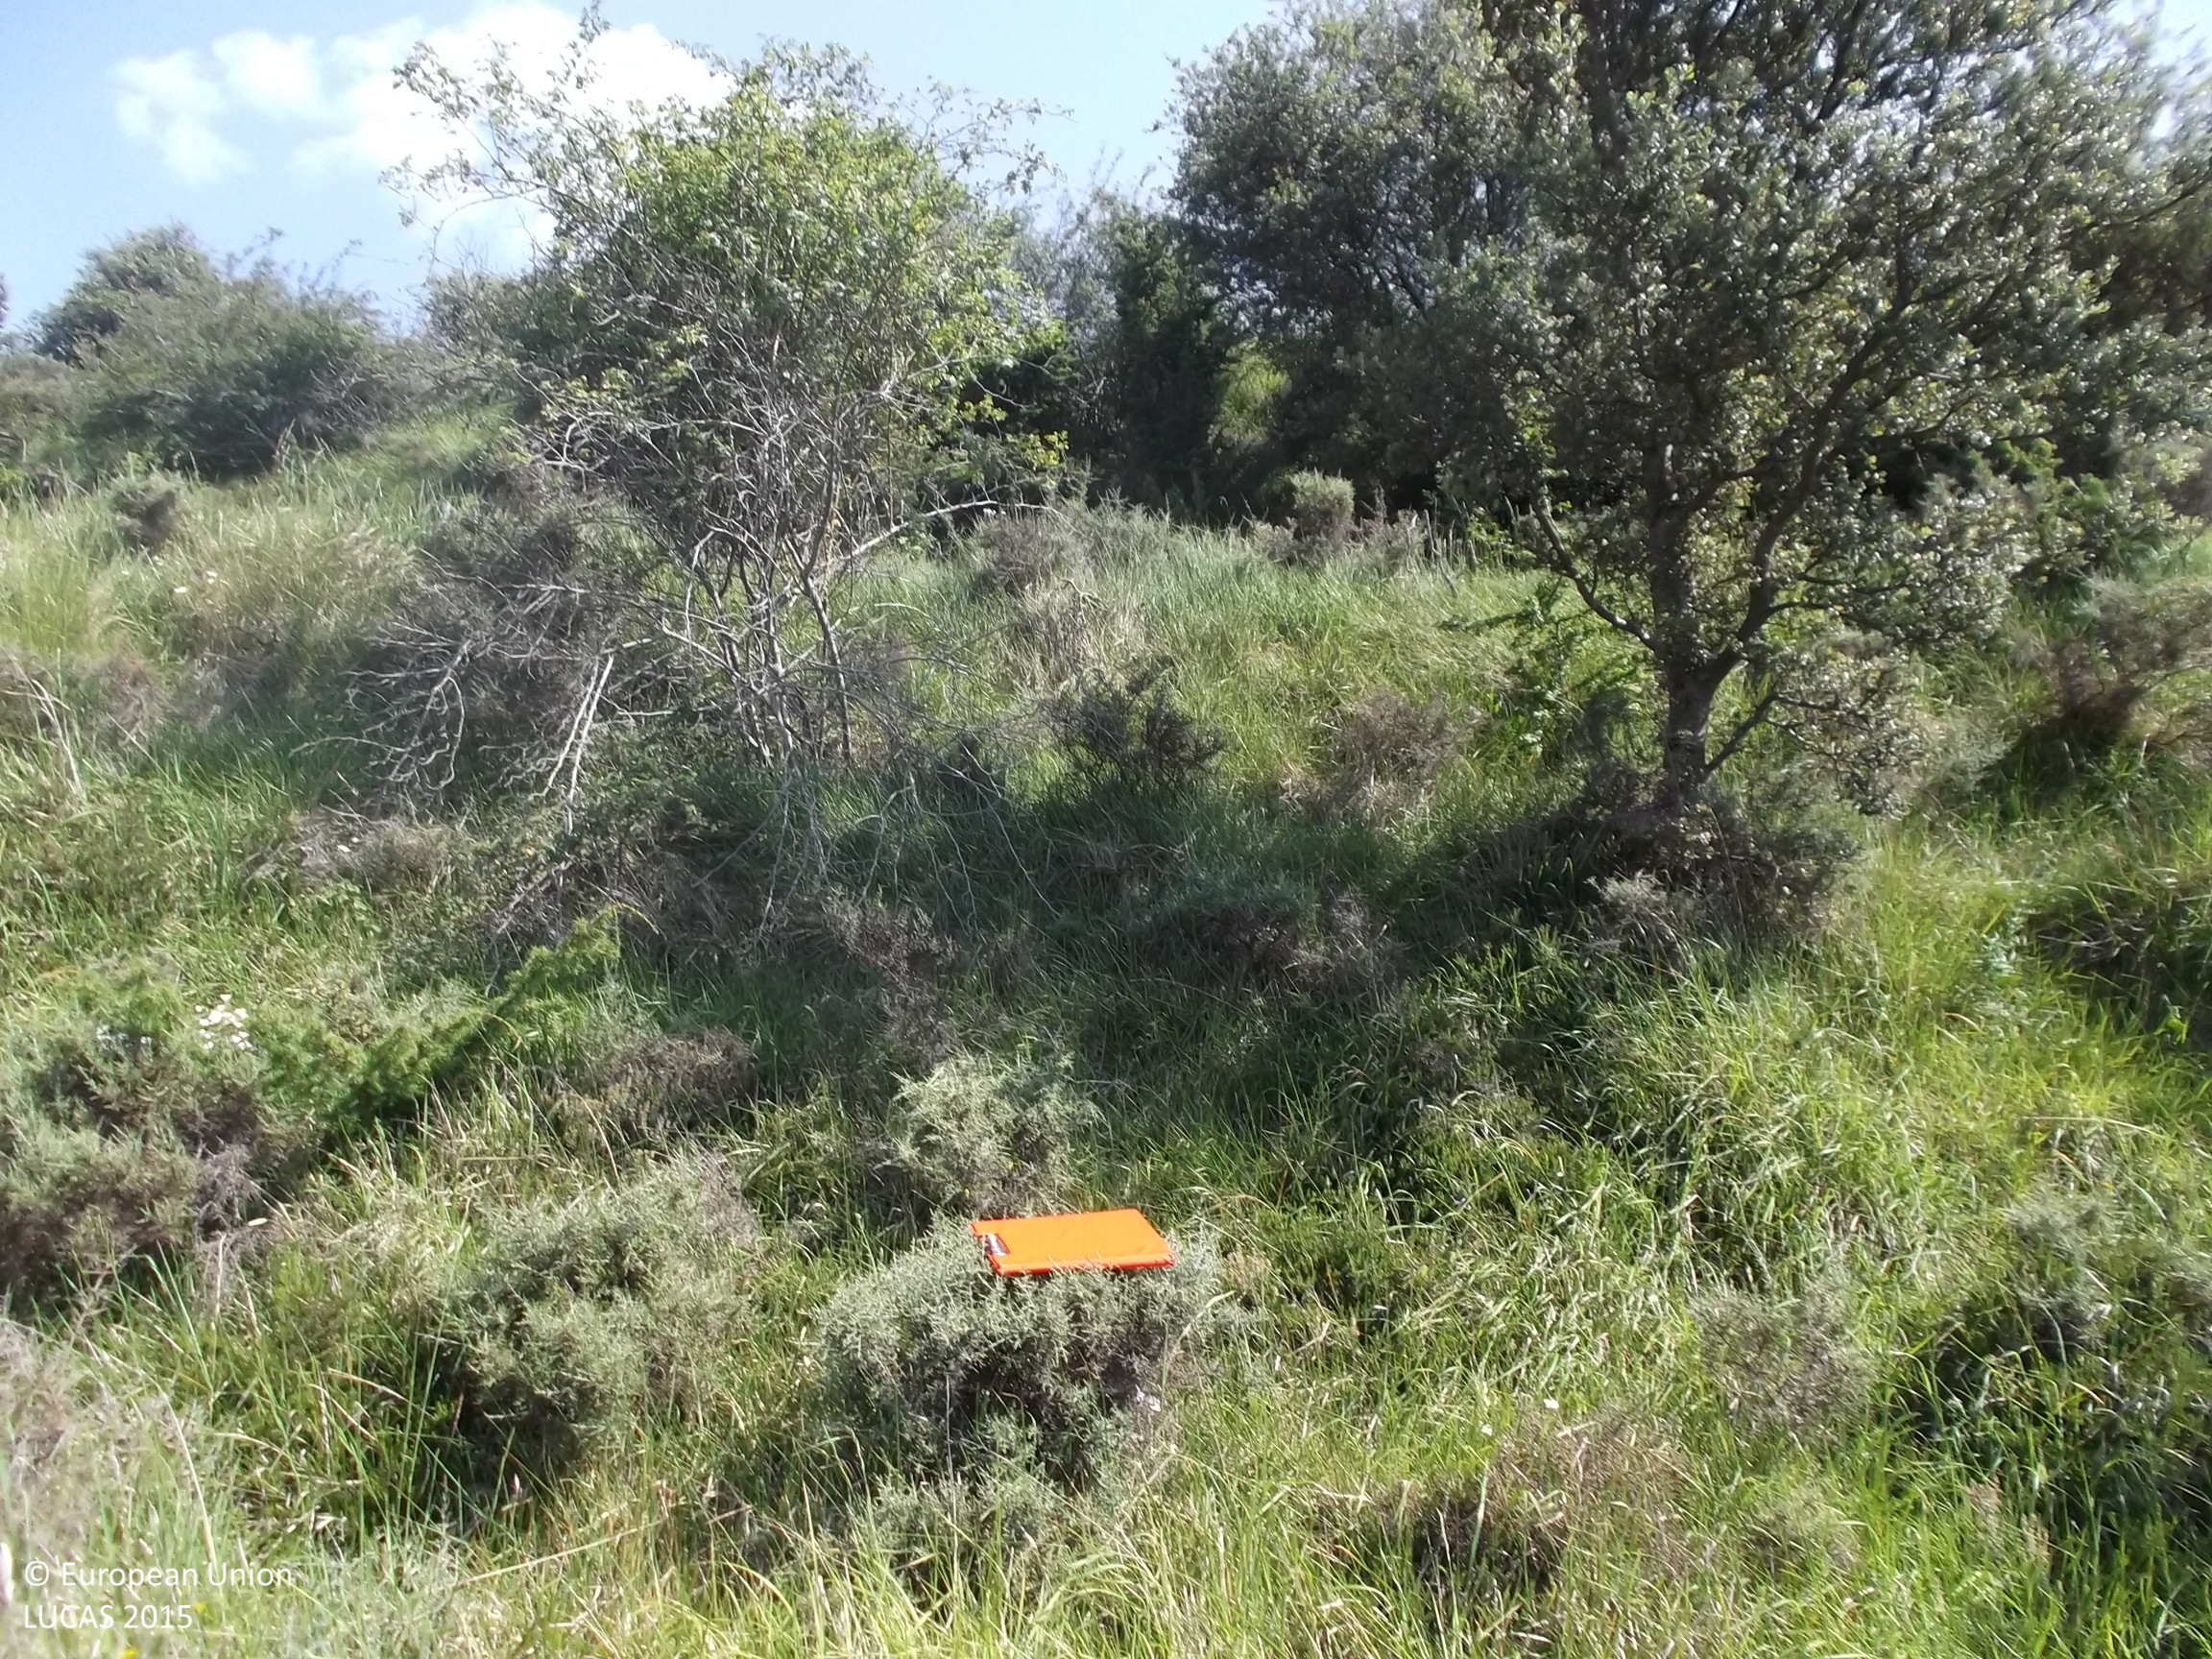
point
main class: Woodland
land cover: Broadleaved woodland
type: broadleaved evergreen forest
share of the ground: 10 - 25 %
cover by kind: shrubs 50 %, herbaceous plants 30 %, broadleaved forest trees 15 %, coniferous forest trees 5 %
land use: Semi-natural and natural areas not in use
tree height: > 5 m
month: June
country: ES
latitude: 42.2931
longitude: -2.2298
